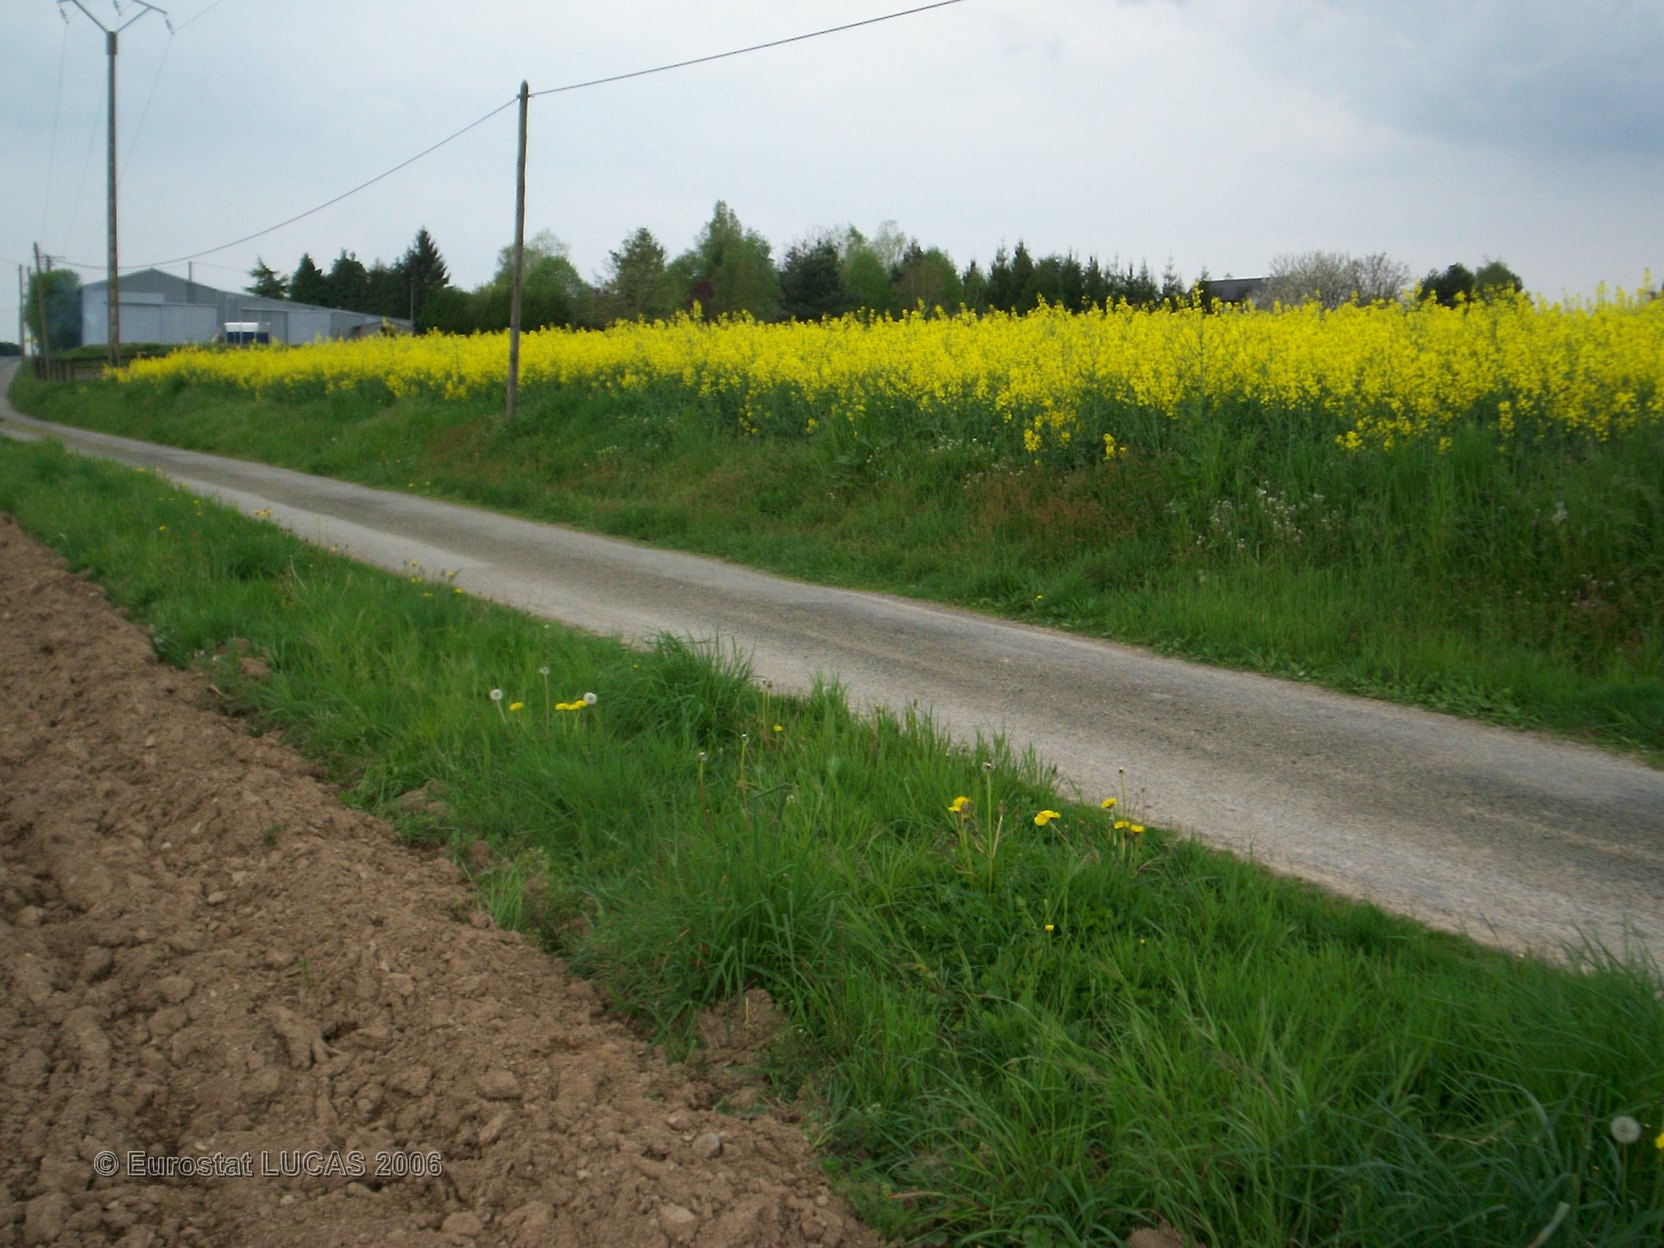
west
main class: Cropland
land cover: Maize
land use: Agriculture (excluding fallow land and kitchen gardens)
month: June
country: FR
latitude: 48.1088
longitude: -1.3388
